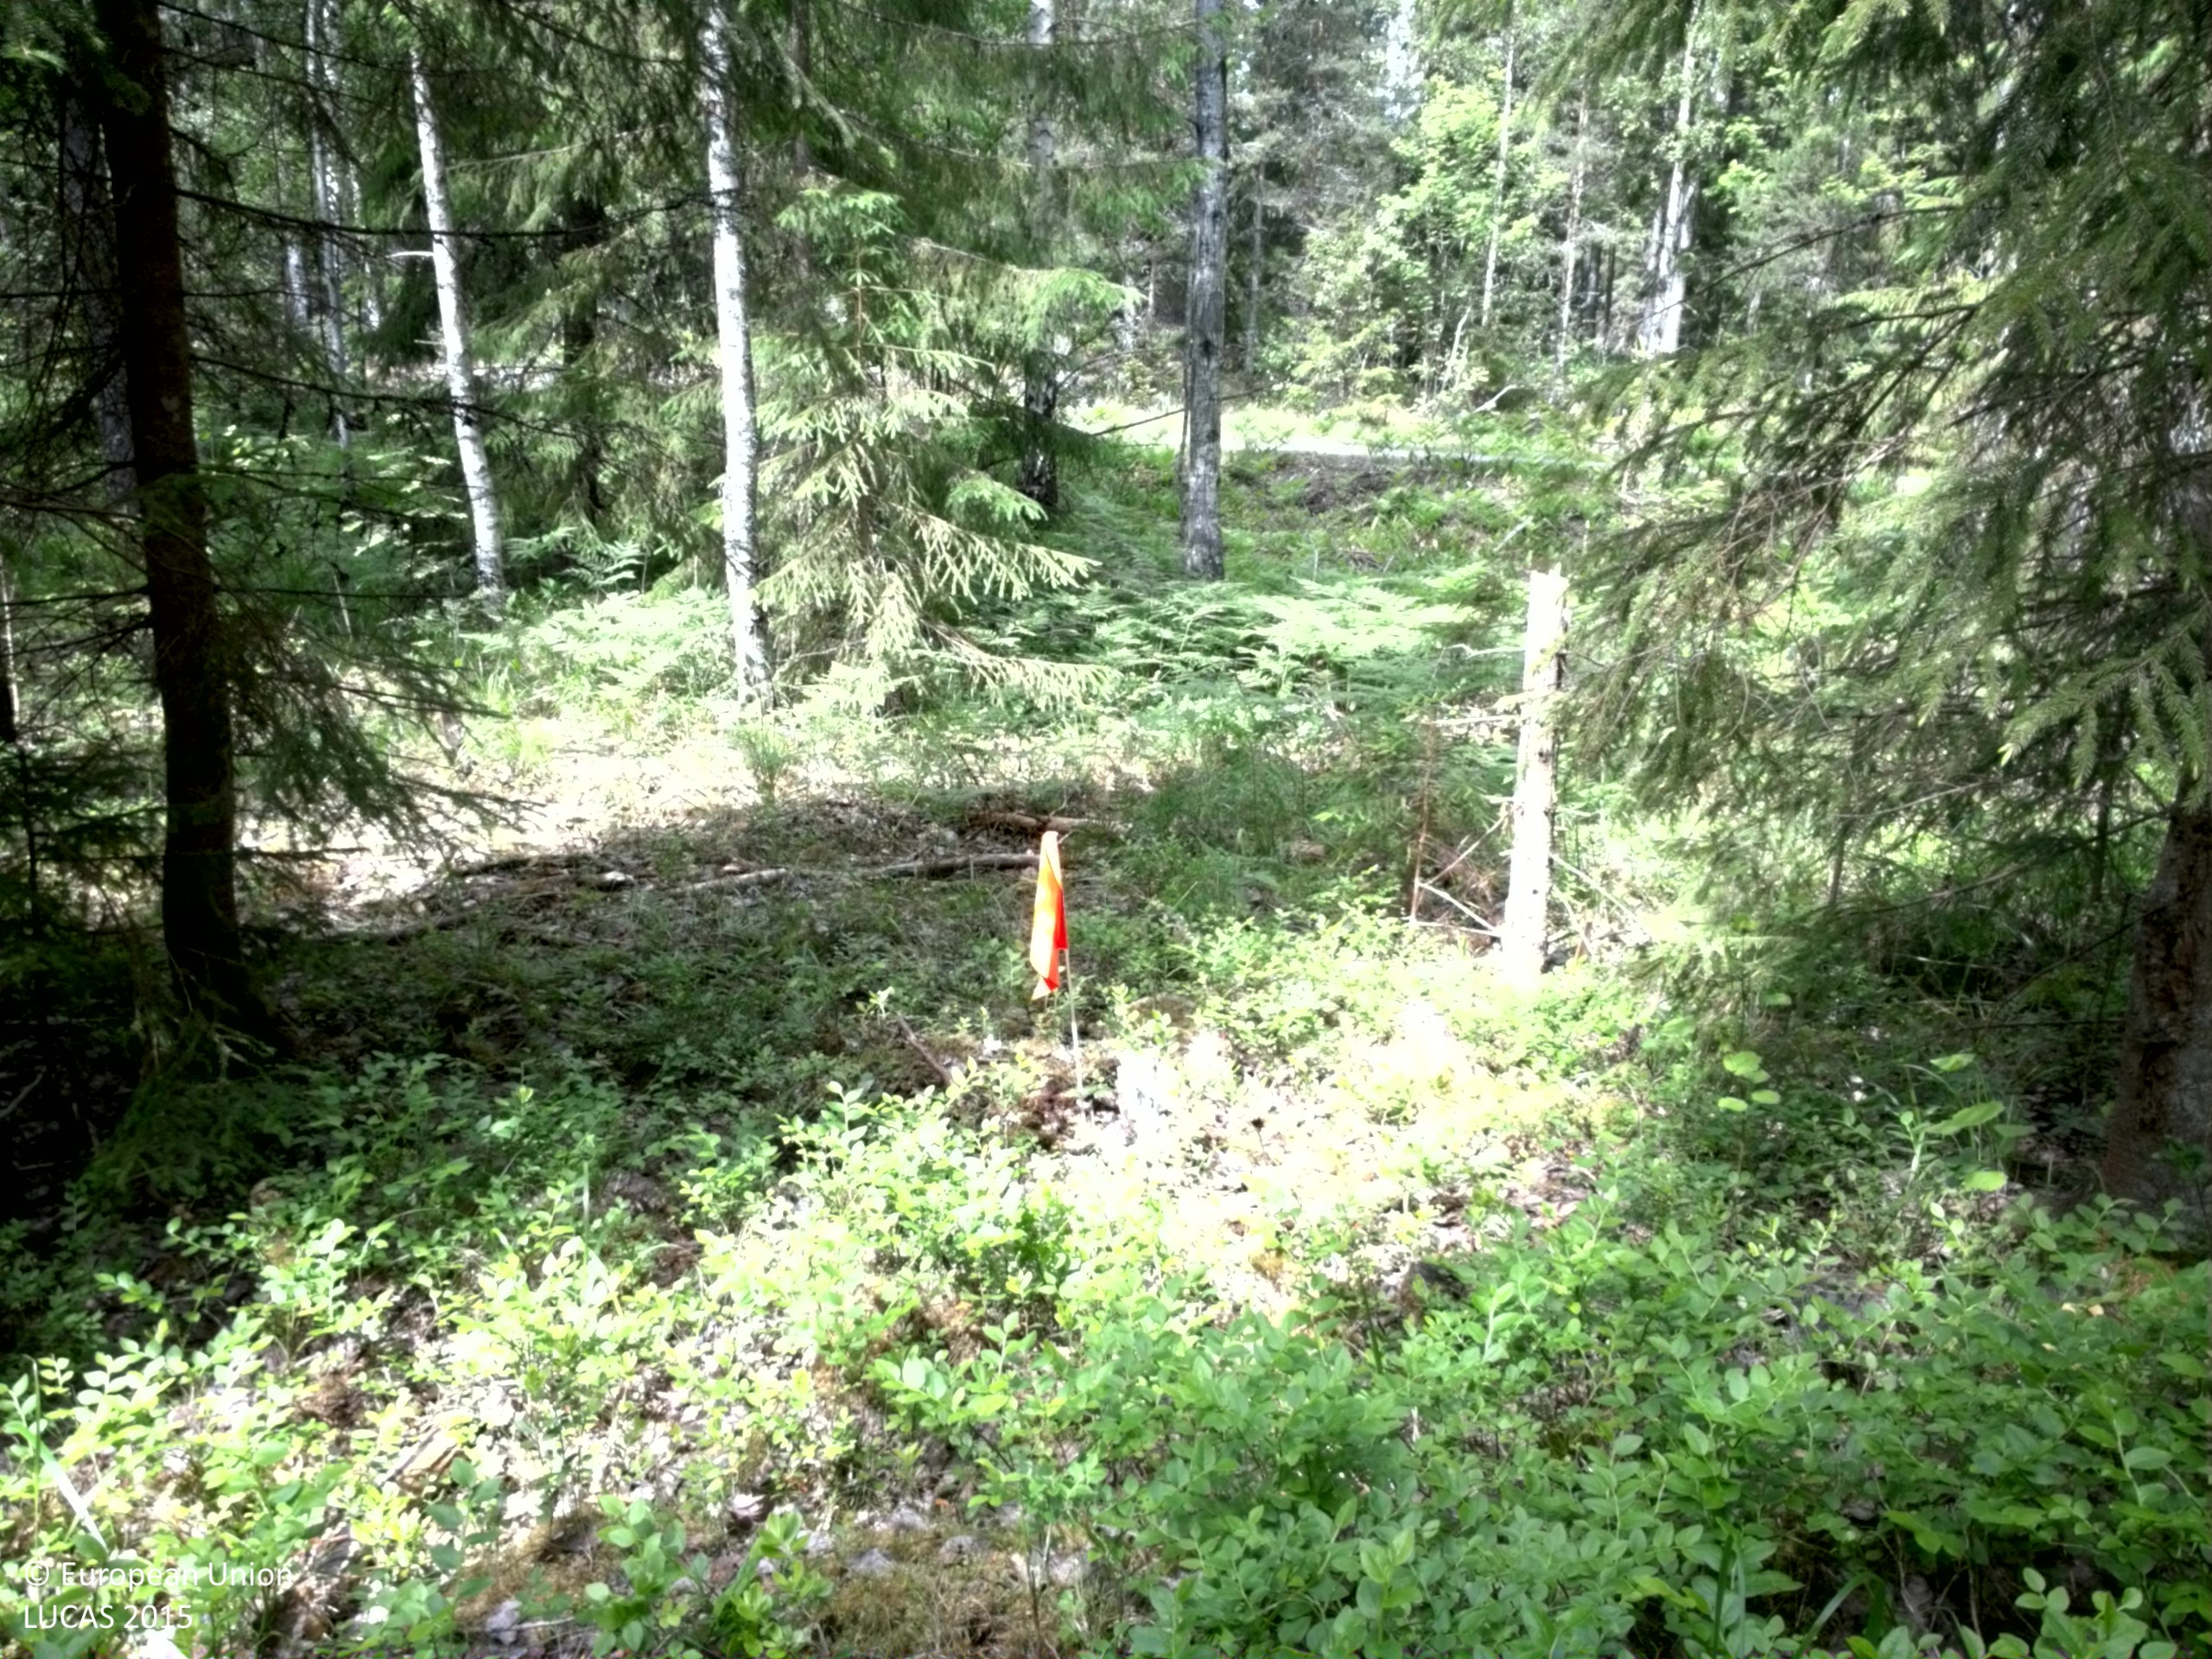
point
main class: Woodland
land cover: Spruce dominated coniferous woodland
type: boreal forest
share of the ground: 50 - 75 %
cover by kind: coniferous forest trees 60 %, broadleaved forest trees 15 %, shrubs 10 %, lichens and mosses 10 %, herbaceous plants 5 %
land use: Forestry
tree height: > 5 m
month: June
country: SE
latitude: 60.3148
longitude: 17.6859
